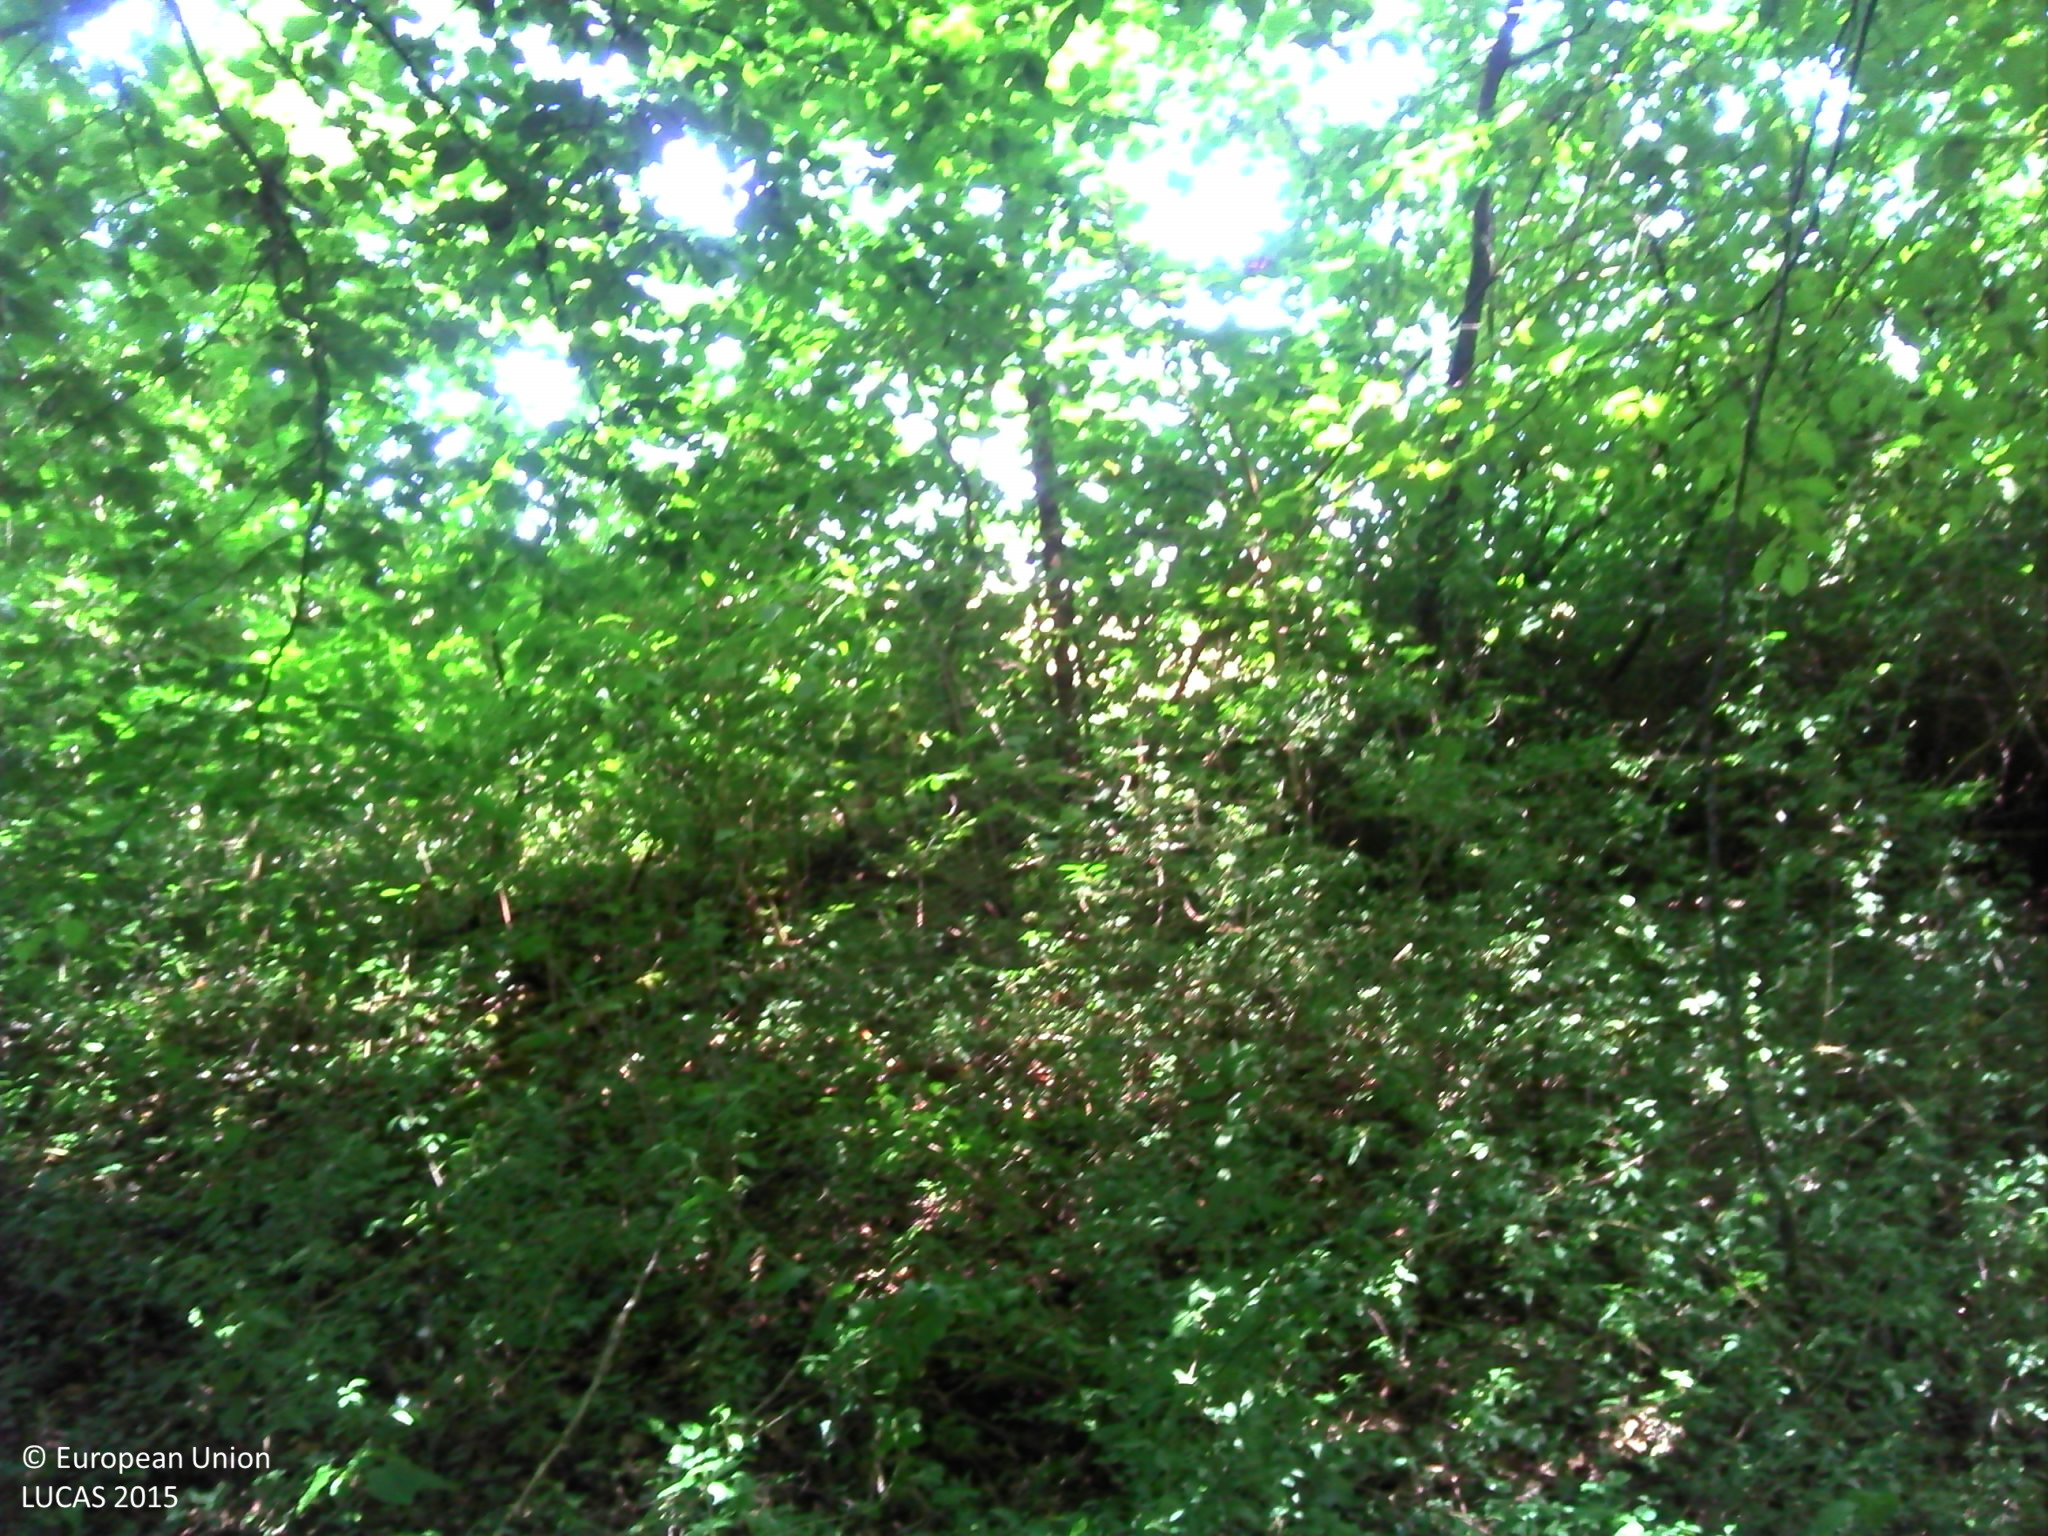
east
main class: Woodland
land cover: Broadleaved woodland
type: beech forest
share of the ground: > 75 %
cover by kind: broadleaved forest trees 90 %, herbaceous plants 10 %
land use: Forestry
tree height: > 5 m
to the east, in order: Broadleaved woodland; Rape and turnip rape; Abandoned hedges; Fences; Grassland with sparse tree/shrub cover; Fences; Grassland without tree/shrub cover
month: June
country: FR
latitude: 47.4571
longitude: 6.2477
